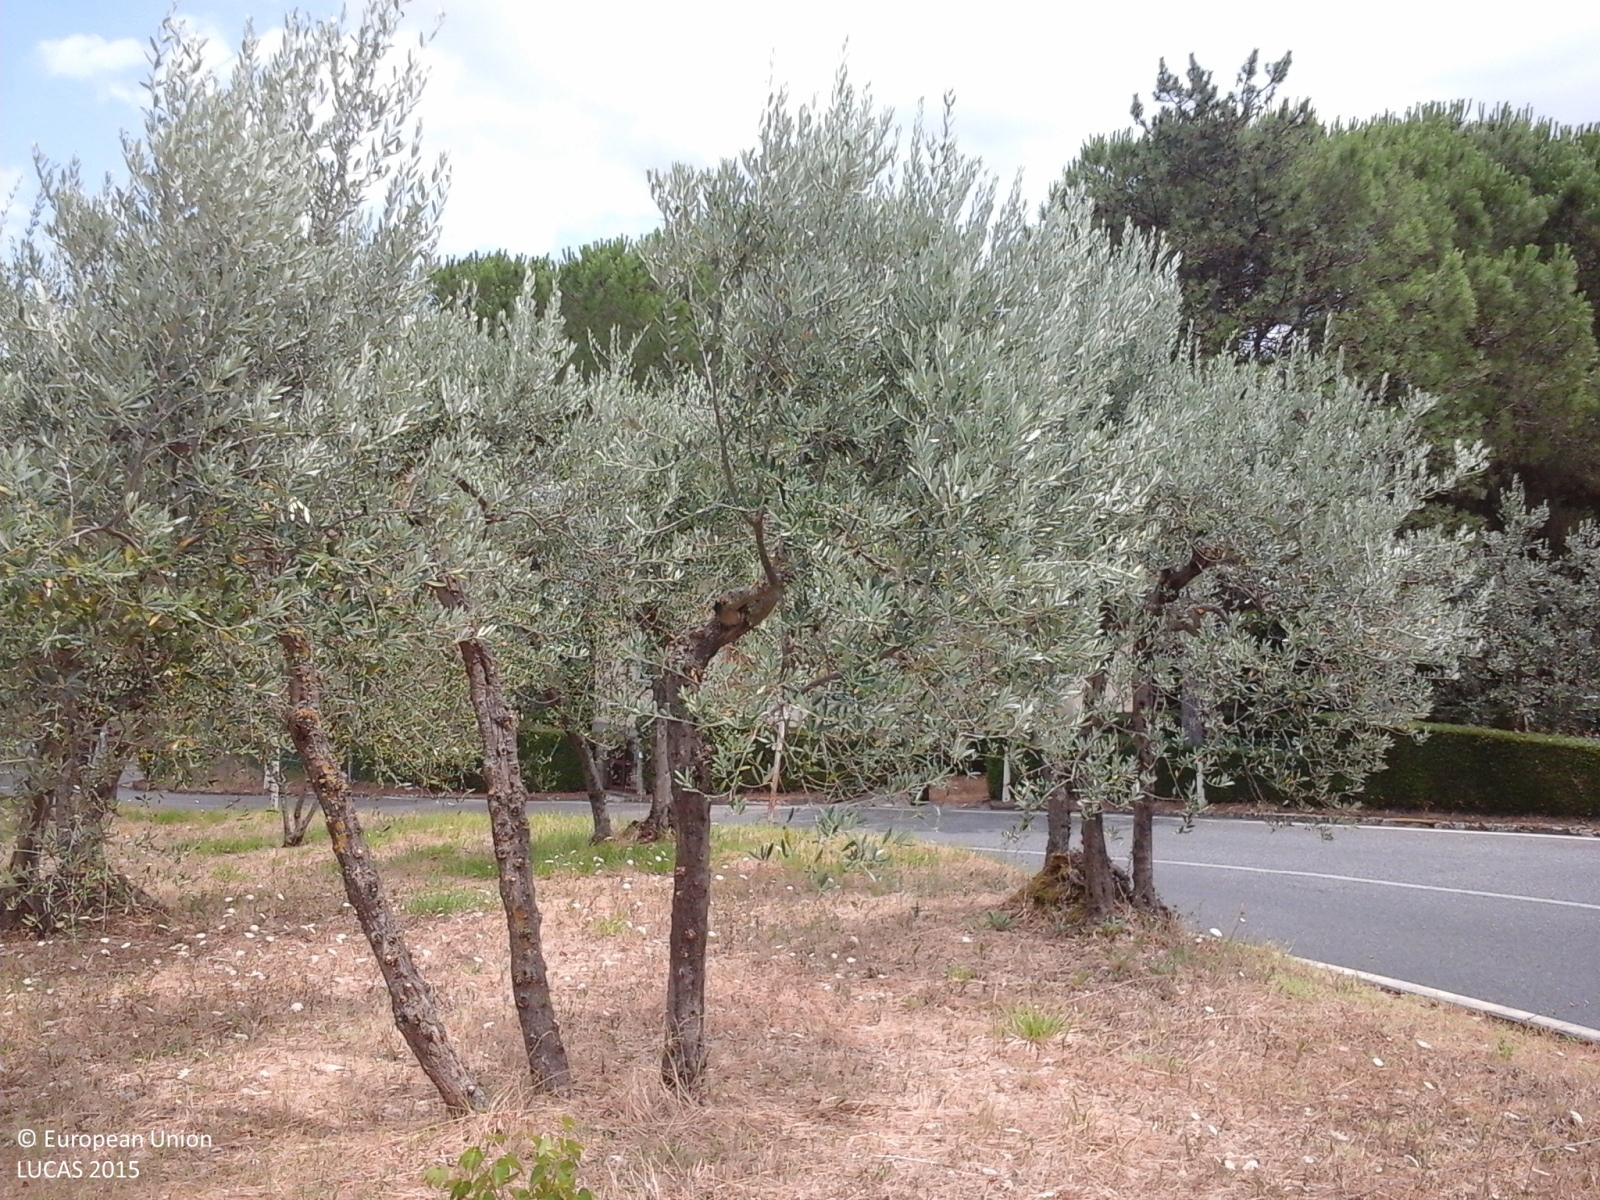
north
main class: Cropland
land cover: Olive groves
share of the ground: > 75 %
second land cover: Spontaneously vegetated surfaces
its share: > 75 %
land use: Agriculture (excluding fallow land and kitchen gardens)
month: July
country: IT
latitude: 43.5343
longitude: 10.9502
